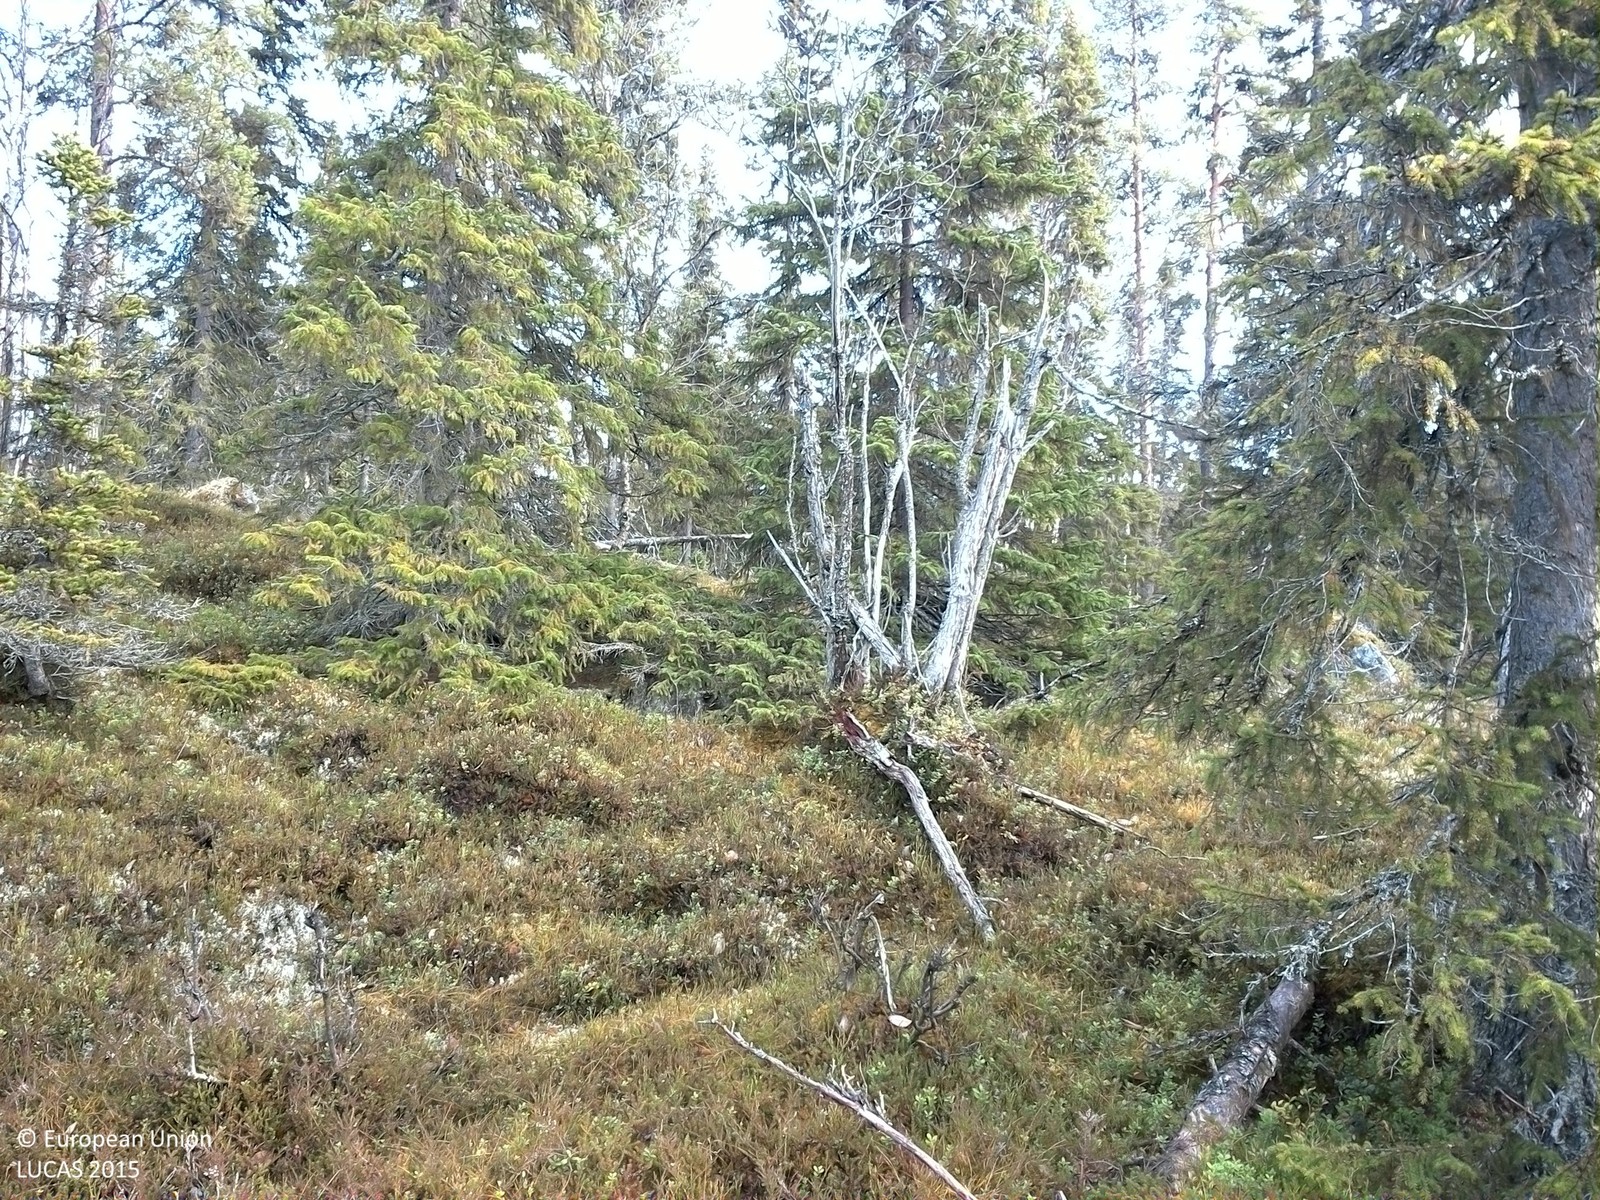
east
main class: Woodland
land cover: Spruce dominated coniferous woodland
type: boreal forest
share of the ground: 25 - 50 %
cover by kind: coniferous forest trees 40 %, shrubs 40 %, lichens and mosses 15 %, broadleaved forest trees 5 %
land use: Forestry
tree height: > 5 m
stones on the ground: < 10 %
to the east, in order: Spruce dominated coniferous woodland; Pine dominated coniferous woodland; Peatbogs; Pine dominated coniferous woodland; Spruce dominated coniferous woodland
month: October
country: SE
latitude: 64.2152
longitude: 14.8568
